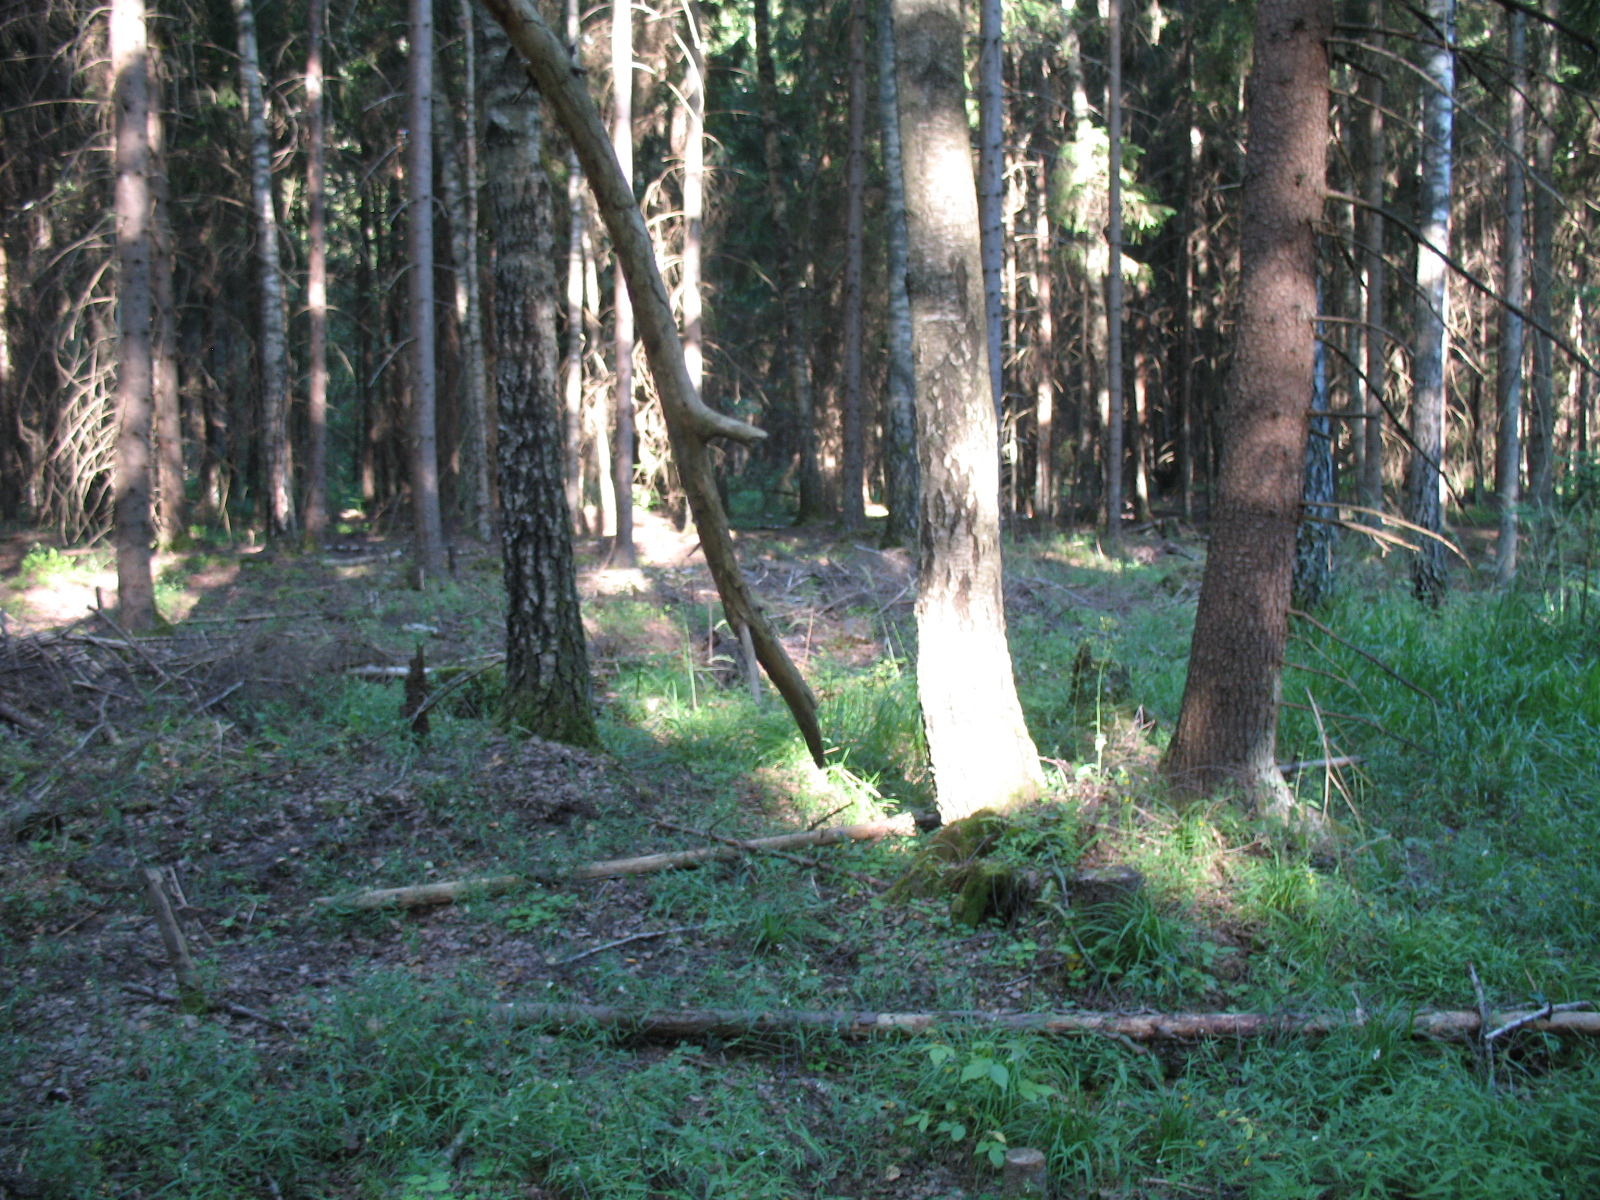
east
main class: Woodland
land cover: Spruce dominated mixed woodland
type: hemiboreal forest and nemoral coniferous forest and mixed broadleaved-coniferous forest
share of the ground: > 75 %
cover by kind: coniferous forest trees 45 %, broadleaved forest trees 45 %, herbaceous plants 5 %, lichens and mosses 5 %
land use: Forestry
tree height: > 5 m
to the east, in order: Spruce dominated mixed woodland; Other coniferous woodland; Spruce dominated mixed woodland; Broadleaved woodland; Spruce dominated mixed woodland; Broadleaved woodland
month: July
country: LV
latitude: 56.7706
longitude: 23.8077
